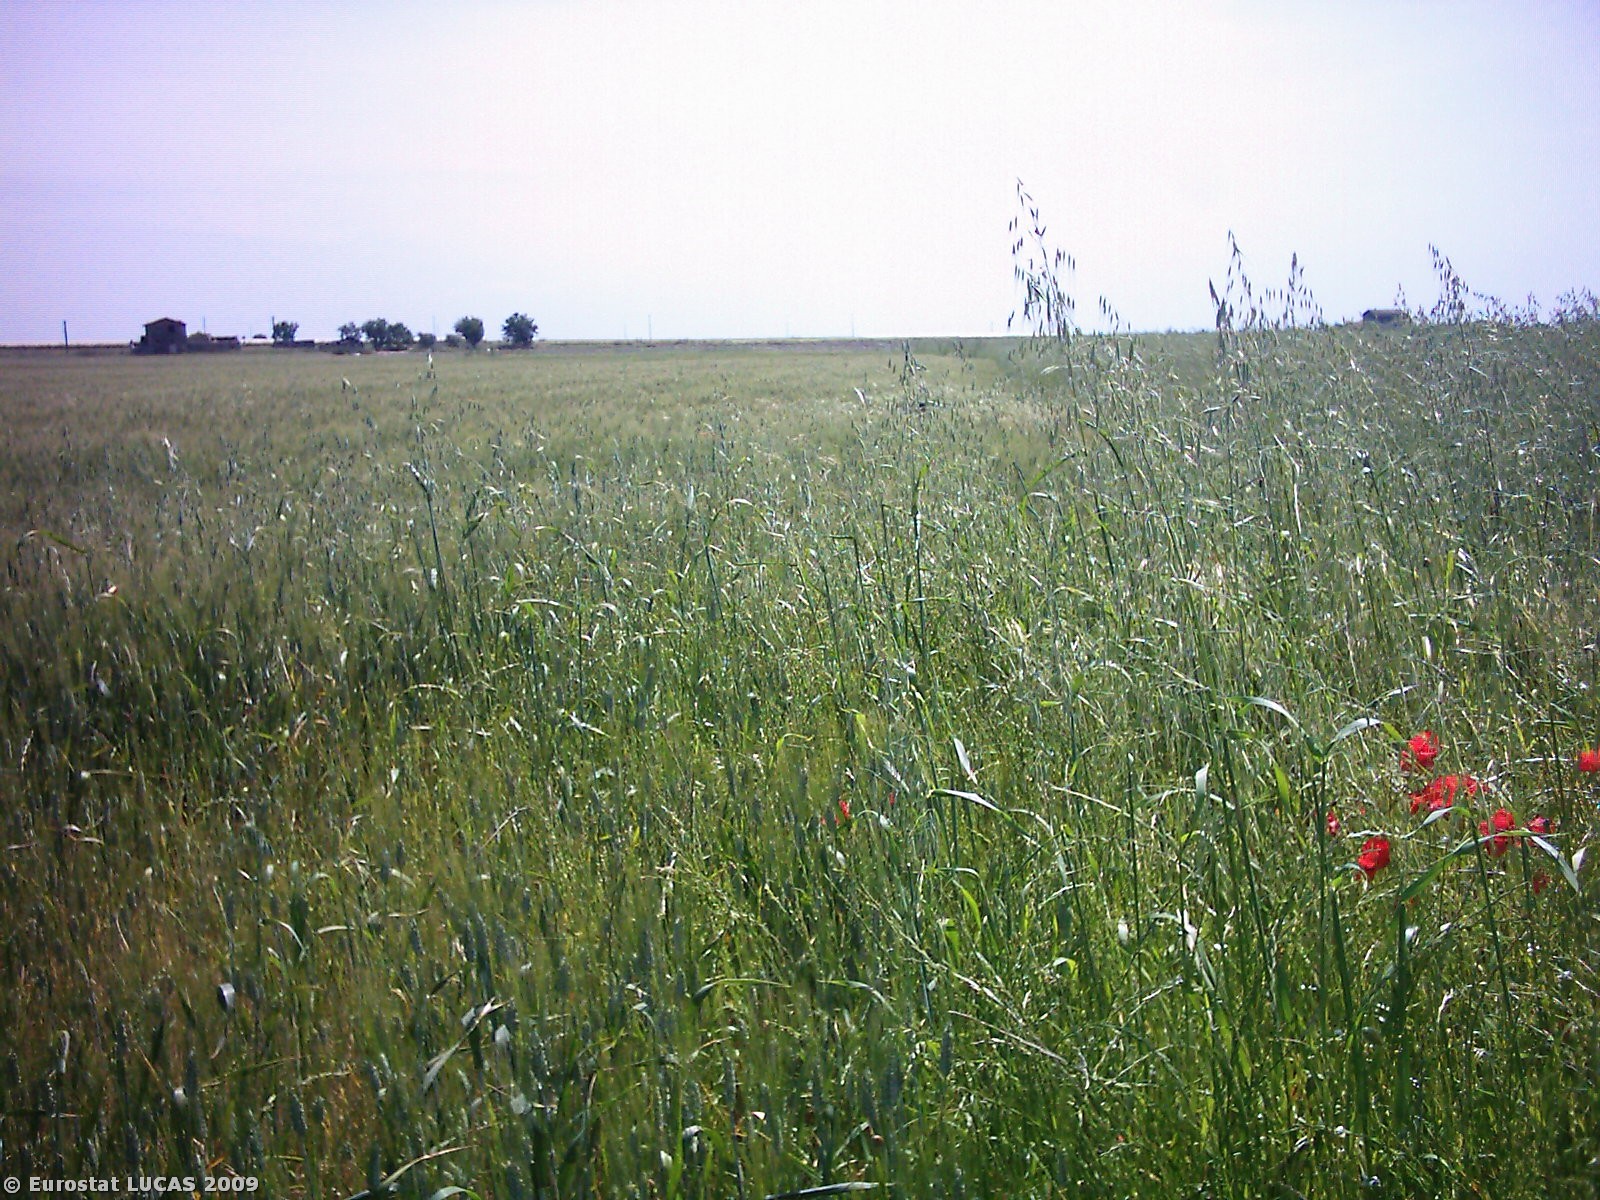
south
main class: Cropland
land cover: Oats
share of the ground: > 75 %
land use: Agriculture (excluding fallow land and kitchen gardens)
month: May
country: IT
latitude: 41.5545
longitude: 15.6532
